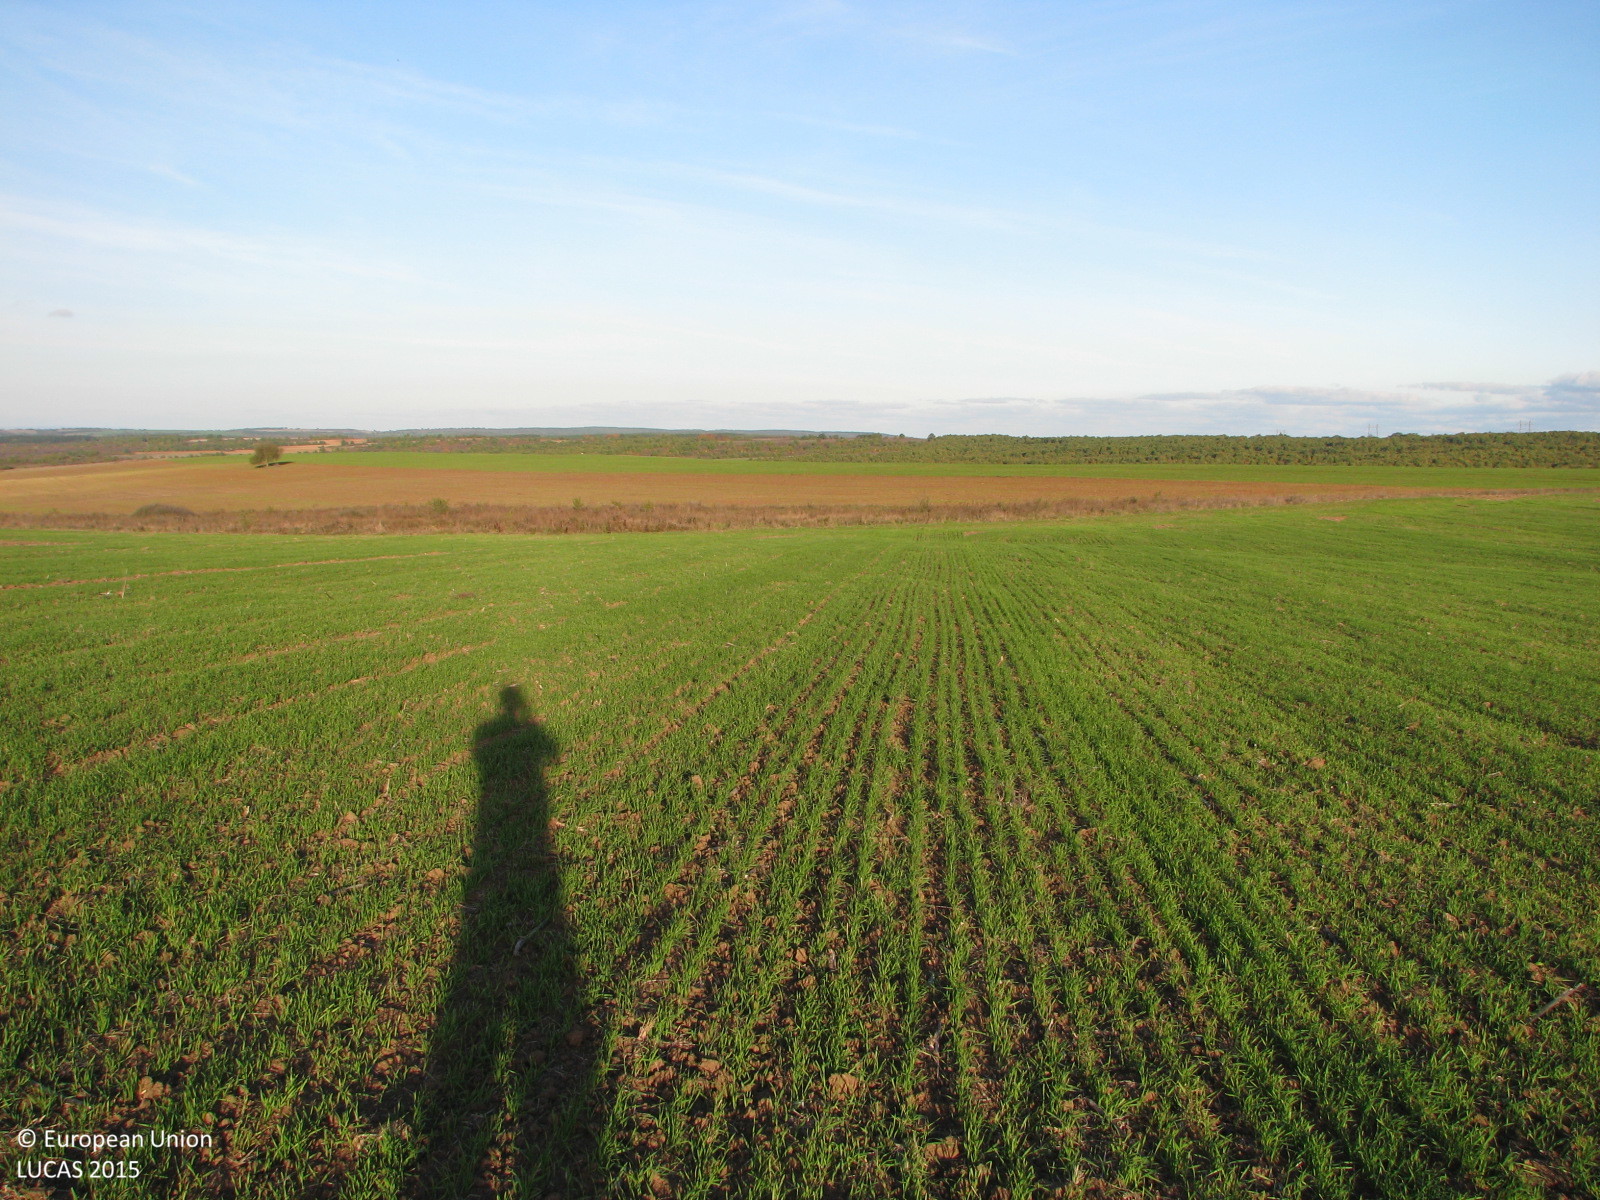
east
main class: Cropland
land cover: Common wheat
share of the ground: > 75 %
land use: Agriculture (excluding fallow land and kitchen gardens)
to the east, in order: Common wheat; Grassland without tree/shrub cover; Tracks; Common wheat
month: October
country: BG
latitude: 42.2847
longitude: 26.8204
